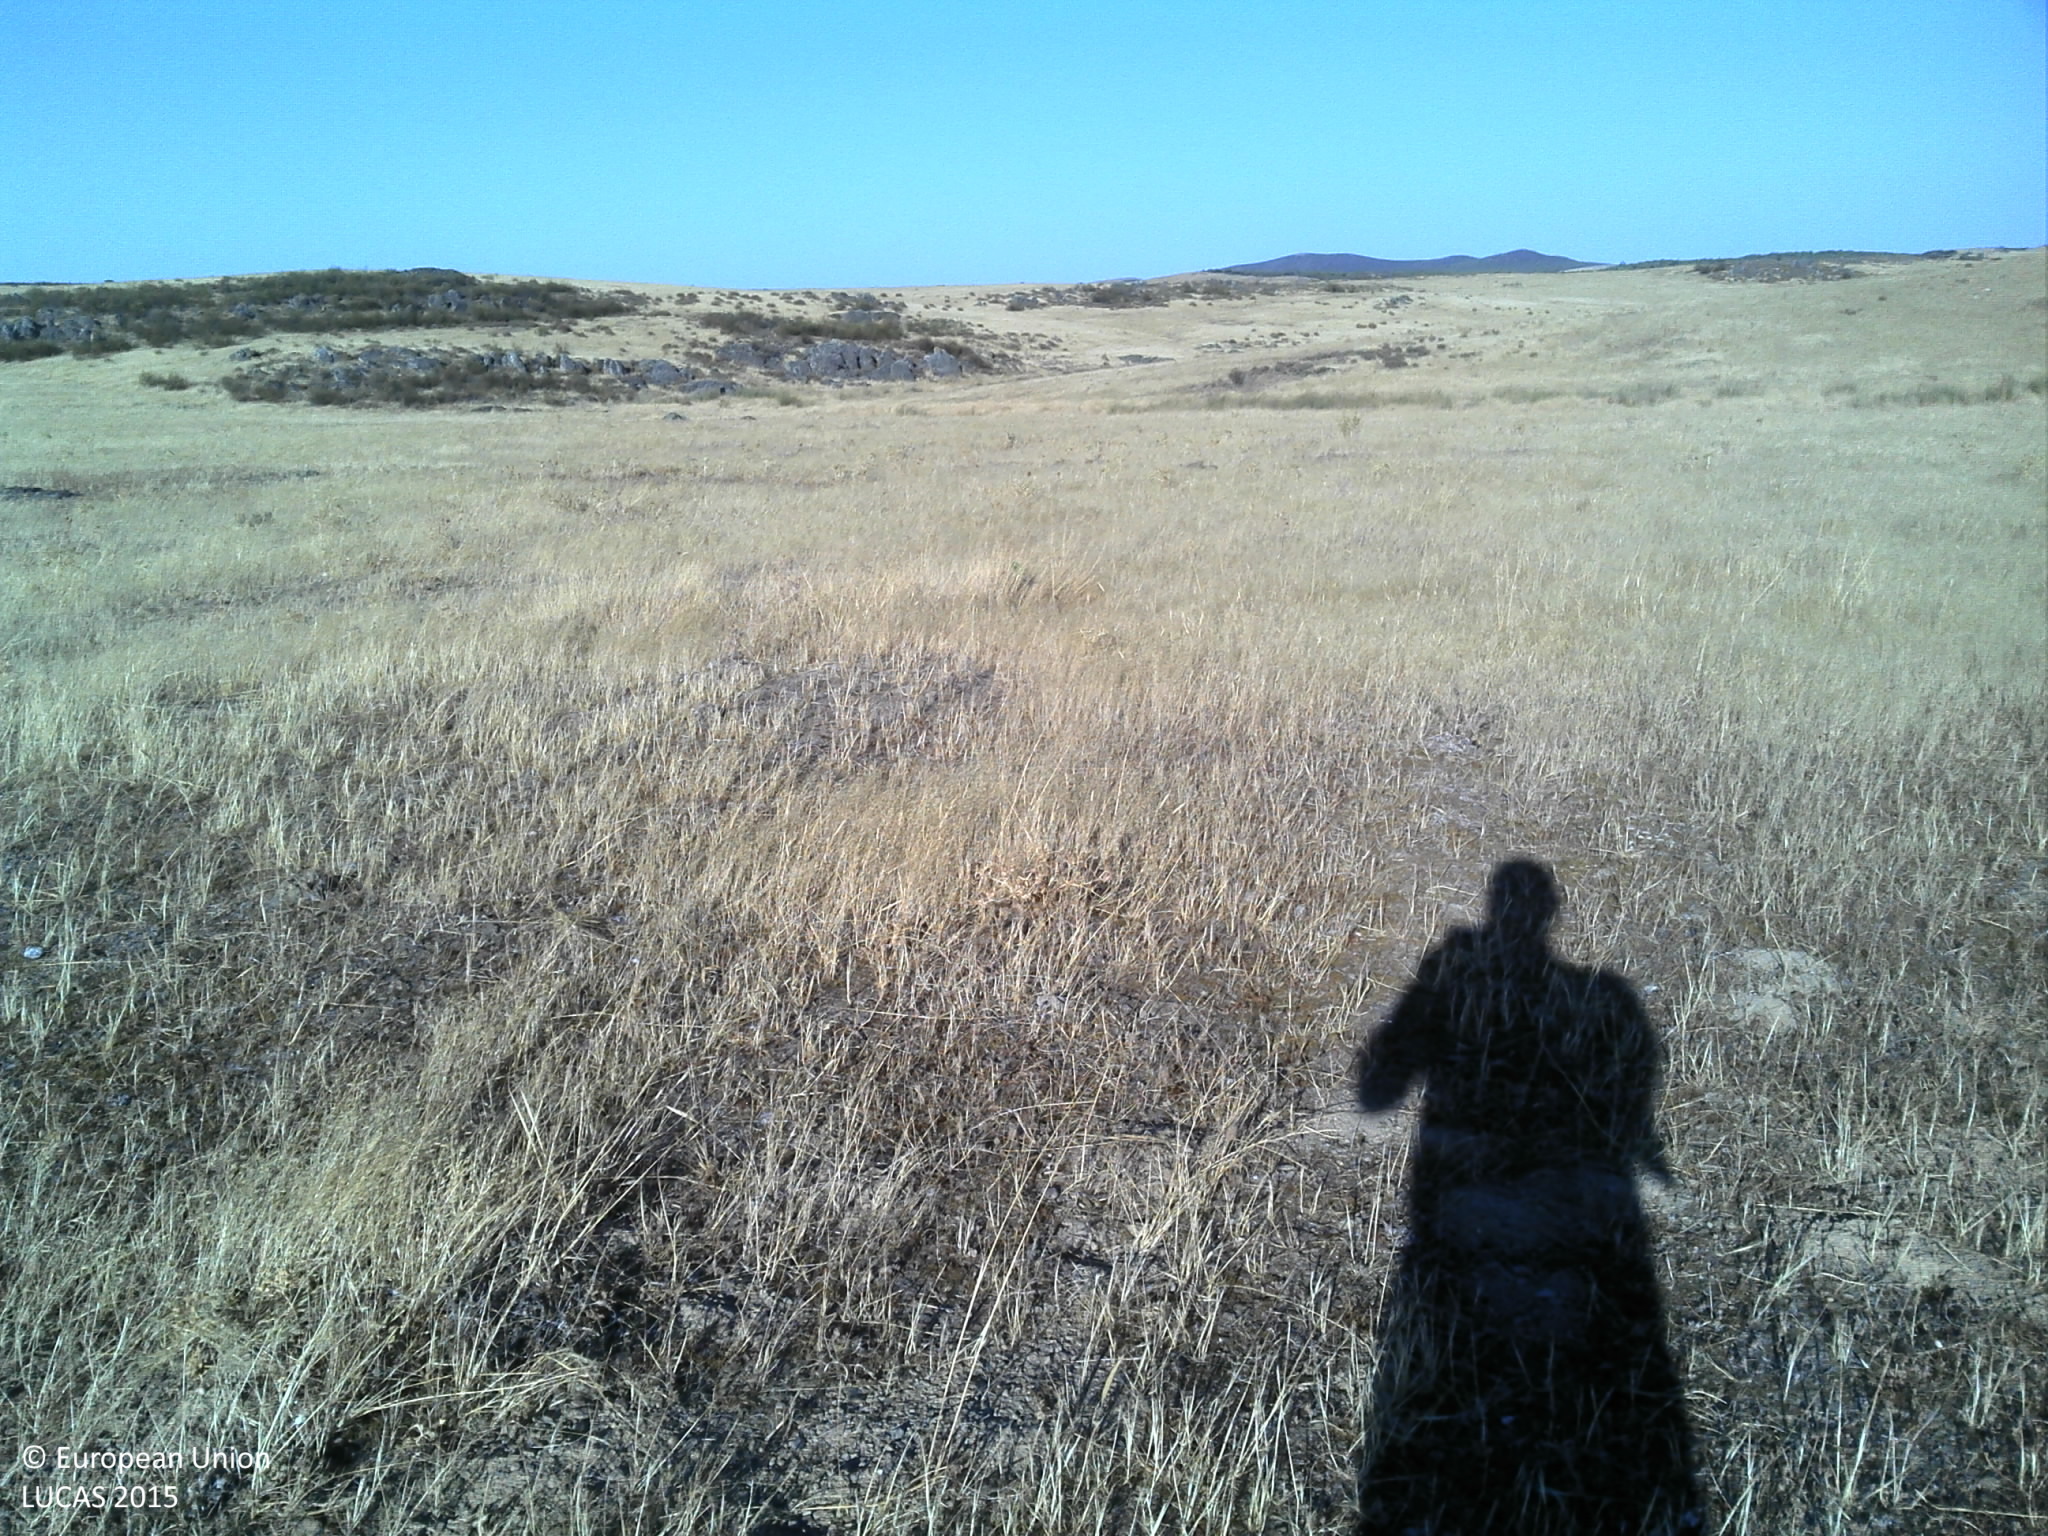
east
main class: Grassland
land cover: Grassland without tree/shrub cover
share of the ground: < 10 %
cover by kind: unconsolidated bare surface 90 %, herbaceous plants 10 %
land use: Agriculture (excluding fallow land and kitchen gardens)
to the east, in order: Grassland without tree/shrub cover; Rivers and streams; Grassland without tree/shrub cover; Rivers and streams; Grassland without tree/shrub cover; Rock outcrops; Grassland without tree/shrub cover
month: July
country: PT
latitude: 37.6632
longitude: -7.8987
